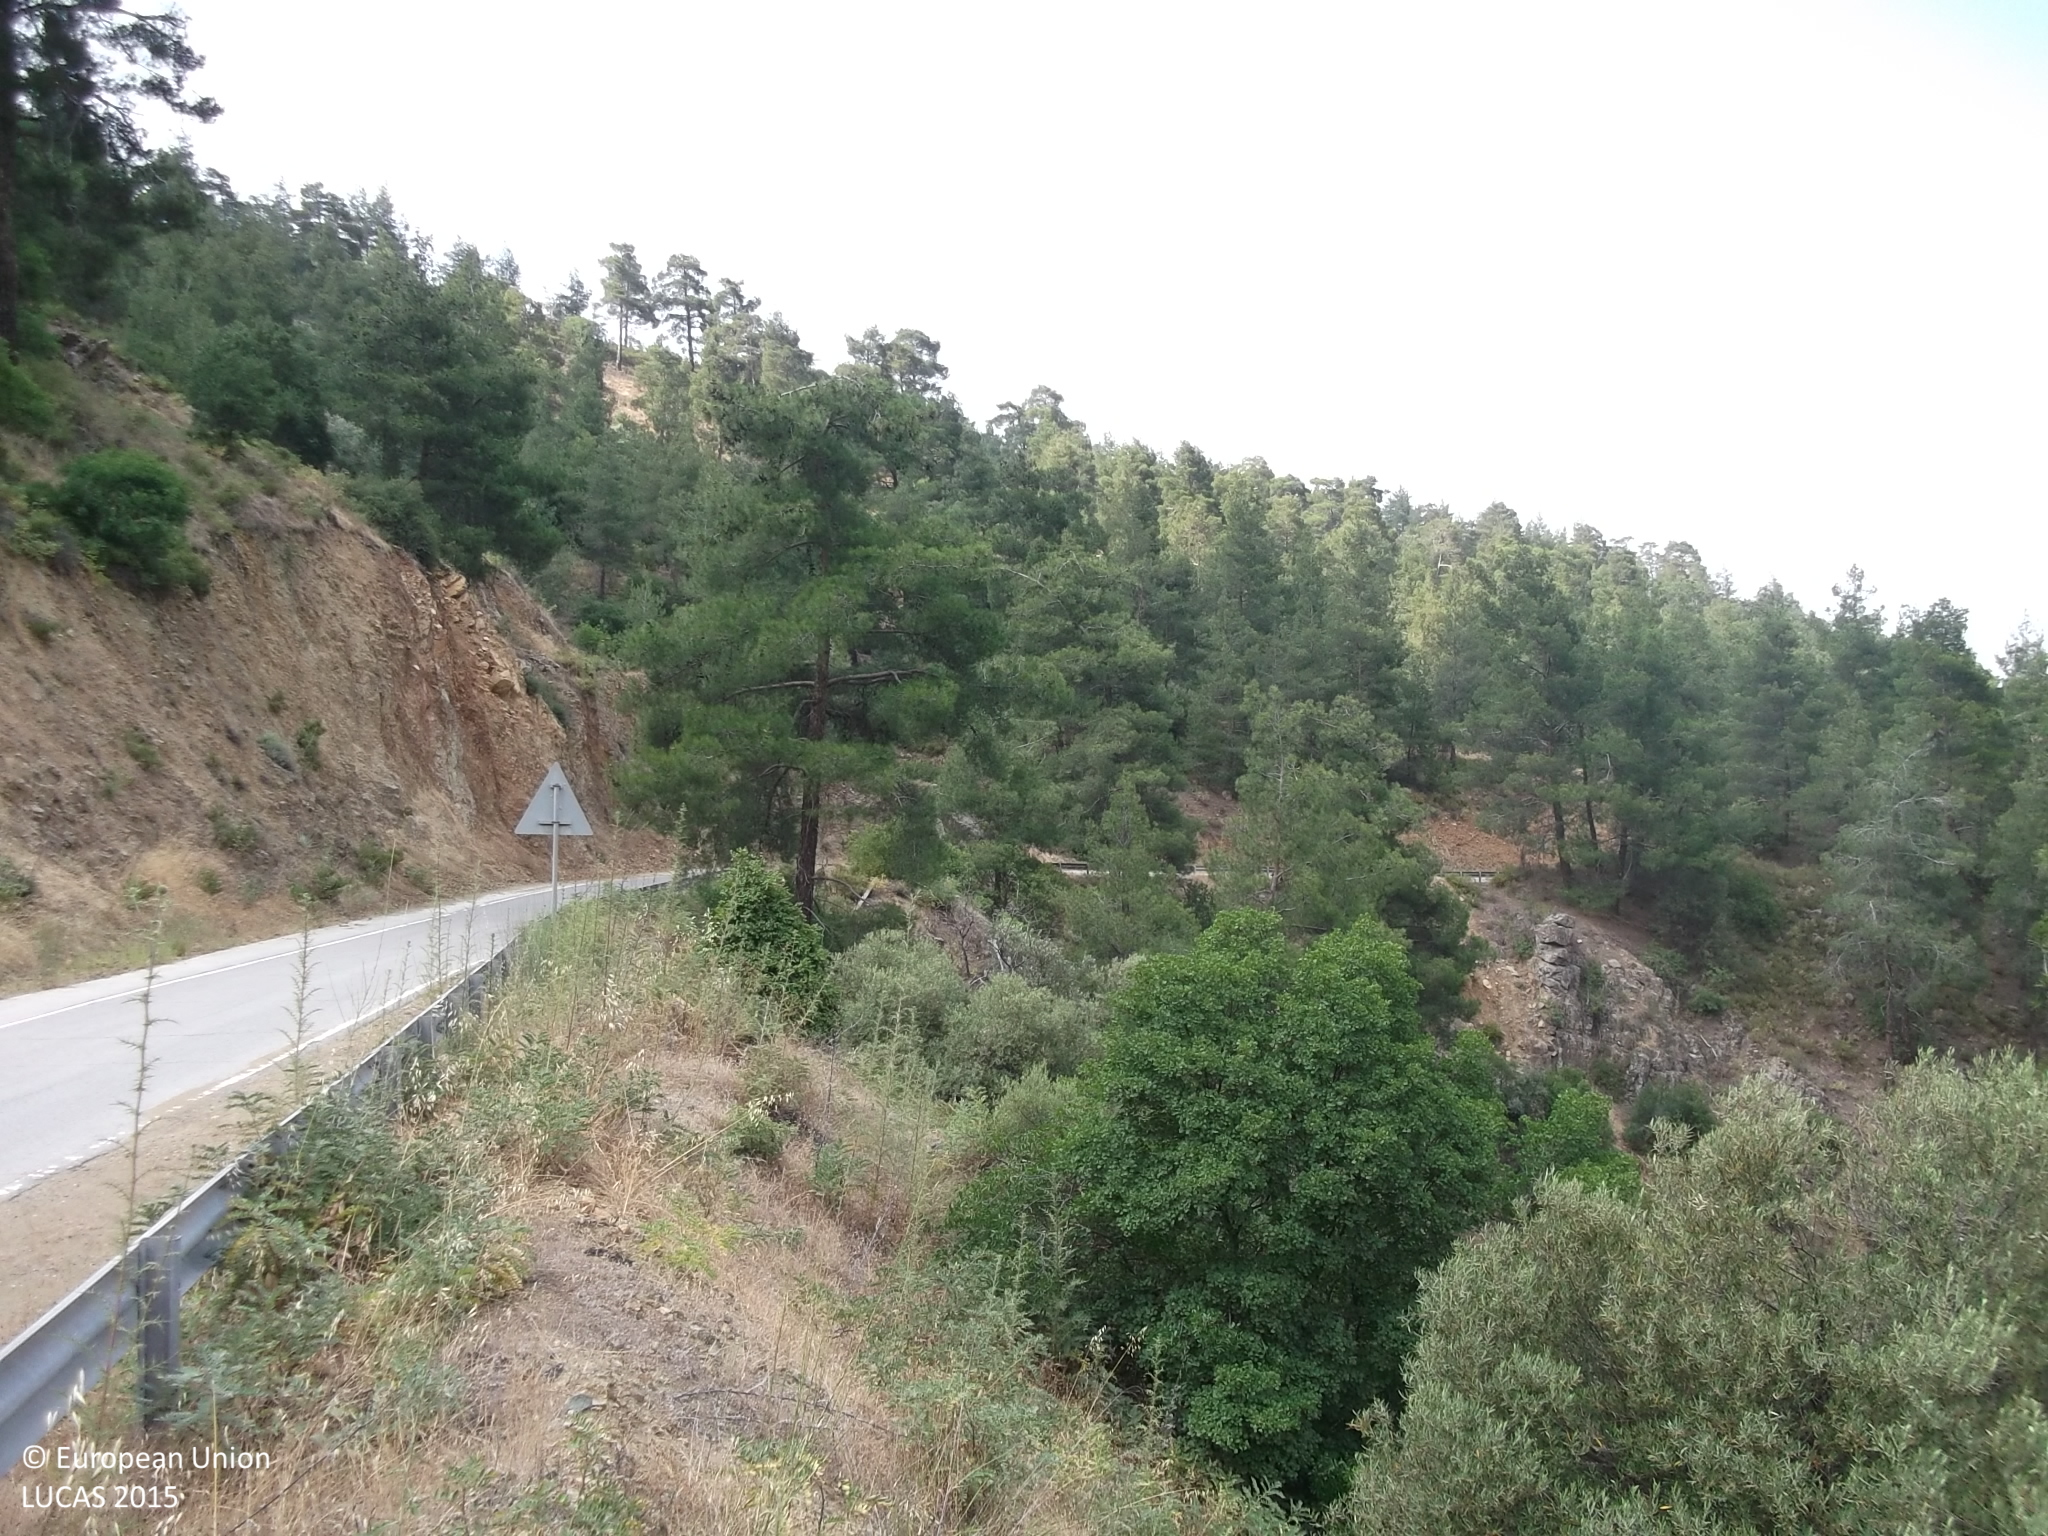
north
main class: Woodland
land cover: Pine dominated coniferous woodland
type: coniferous forest of the mediterranean region
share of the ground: 50 - 75 %
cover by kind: coniferous forest trees 60 %, shrubs 20 %, consolidated bare surface 10 %, unconsolidated bare surface 10 %
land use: Forestry
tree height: > 5 m
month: June
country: CY
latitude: 35.0010
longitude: 32.9970
